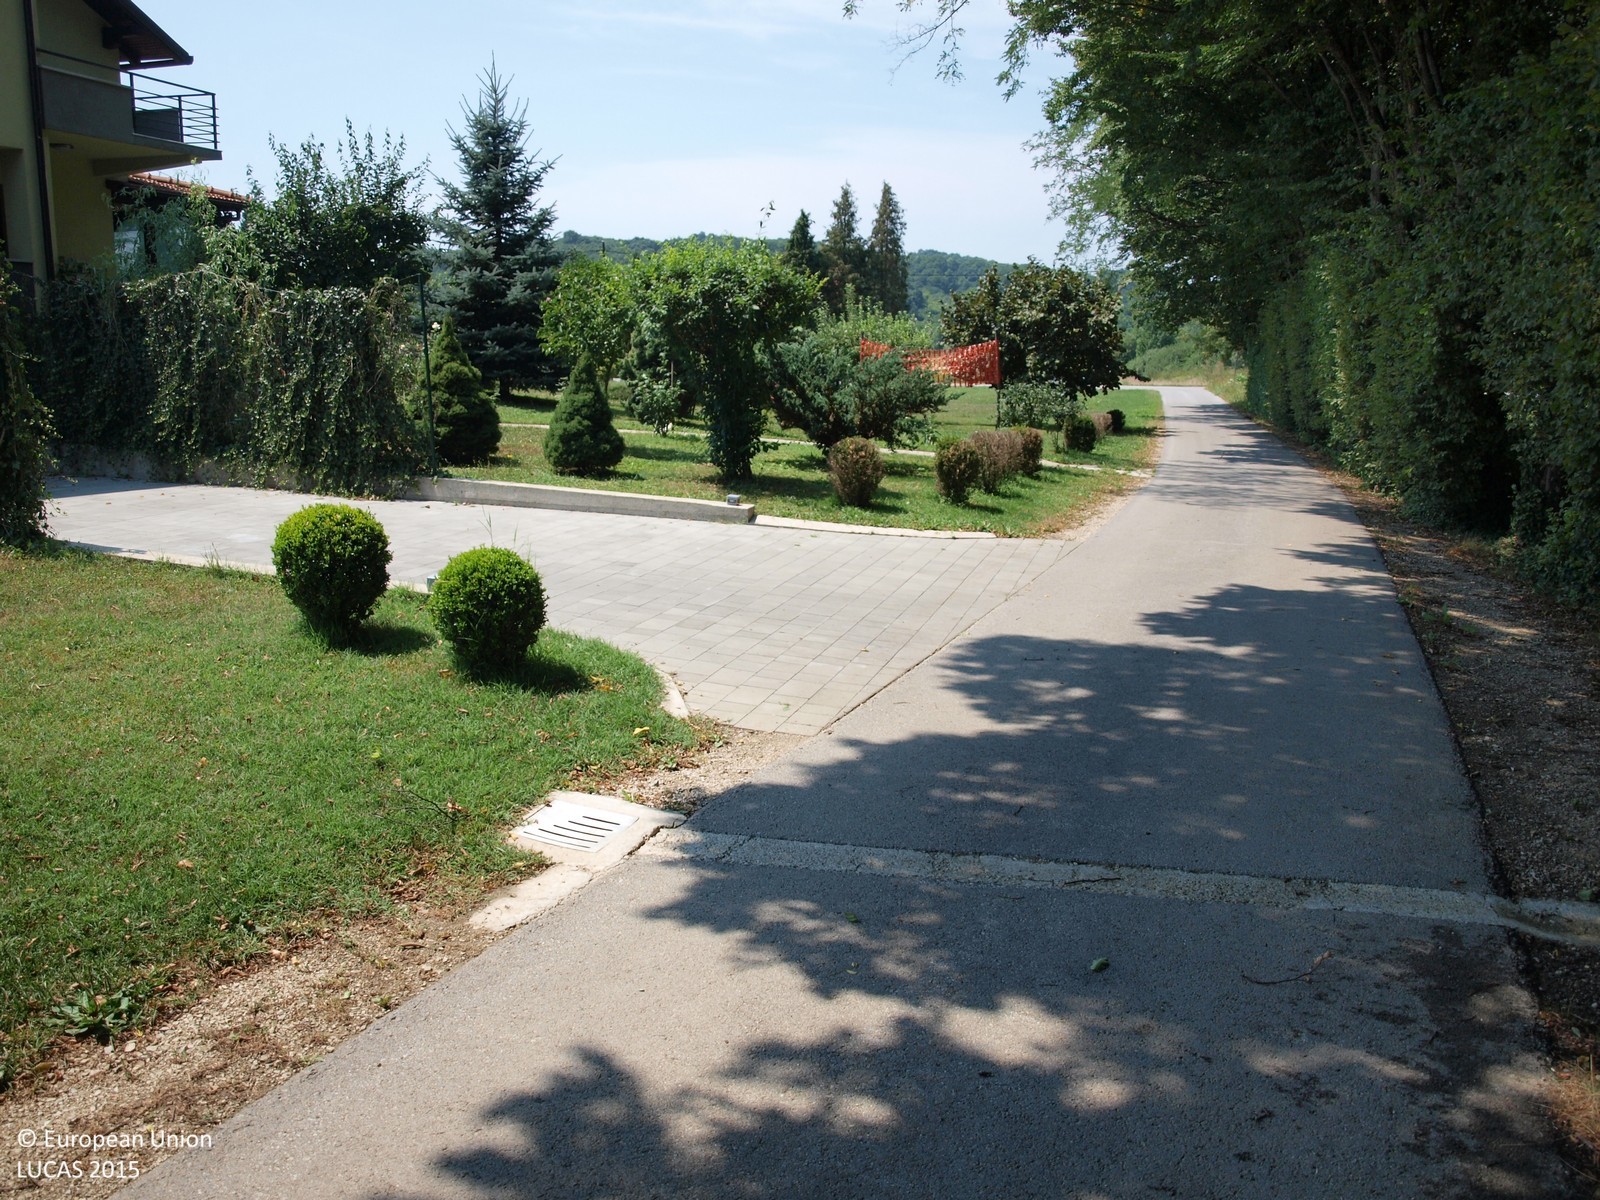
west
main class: Woodland
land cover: Broadleaved woodland
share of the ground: > 75 %
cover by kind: broadleaved forest trees 100 %
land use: Forestry
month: July
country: HR
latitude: 46.0141
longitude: 16.1079
